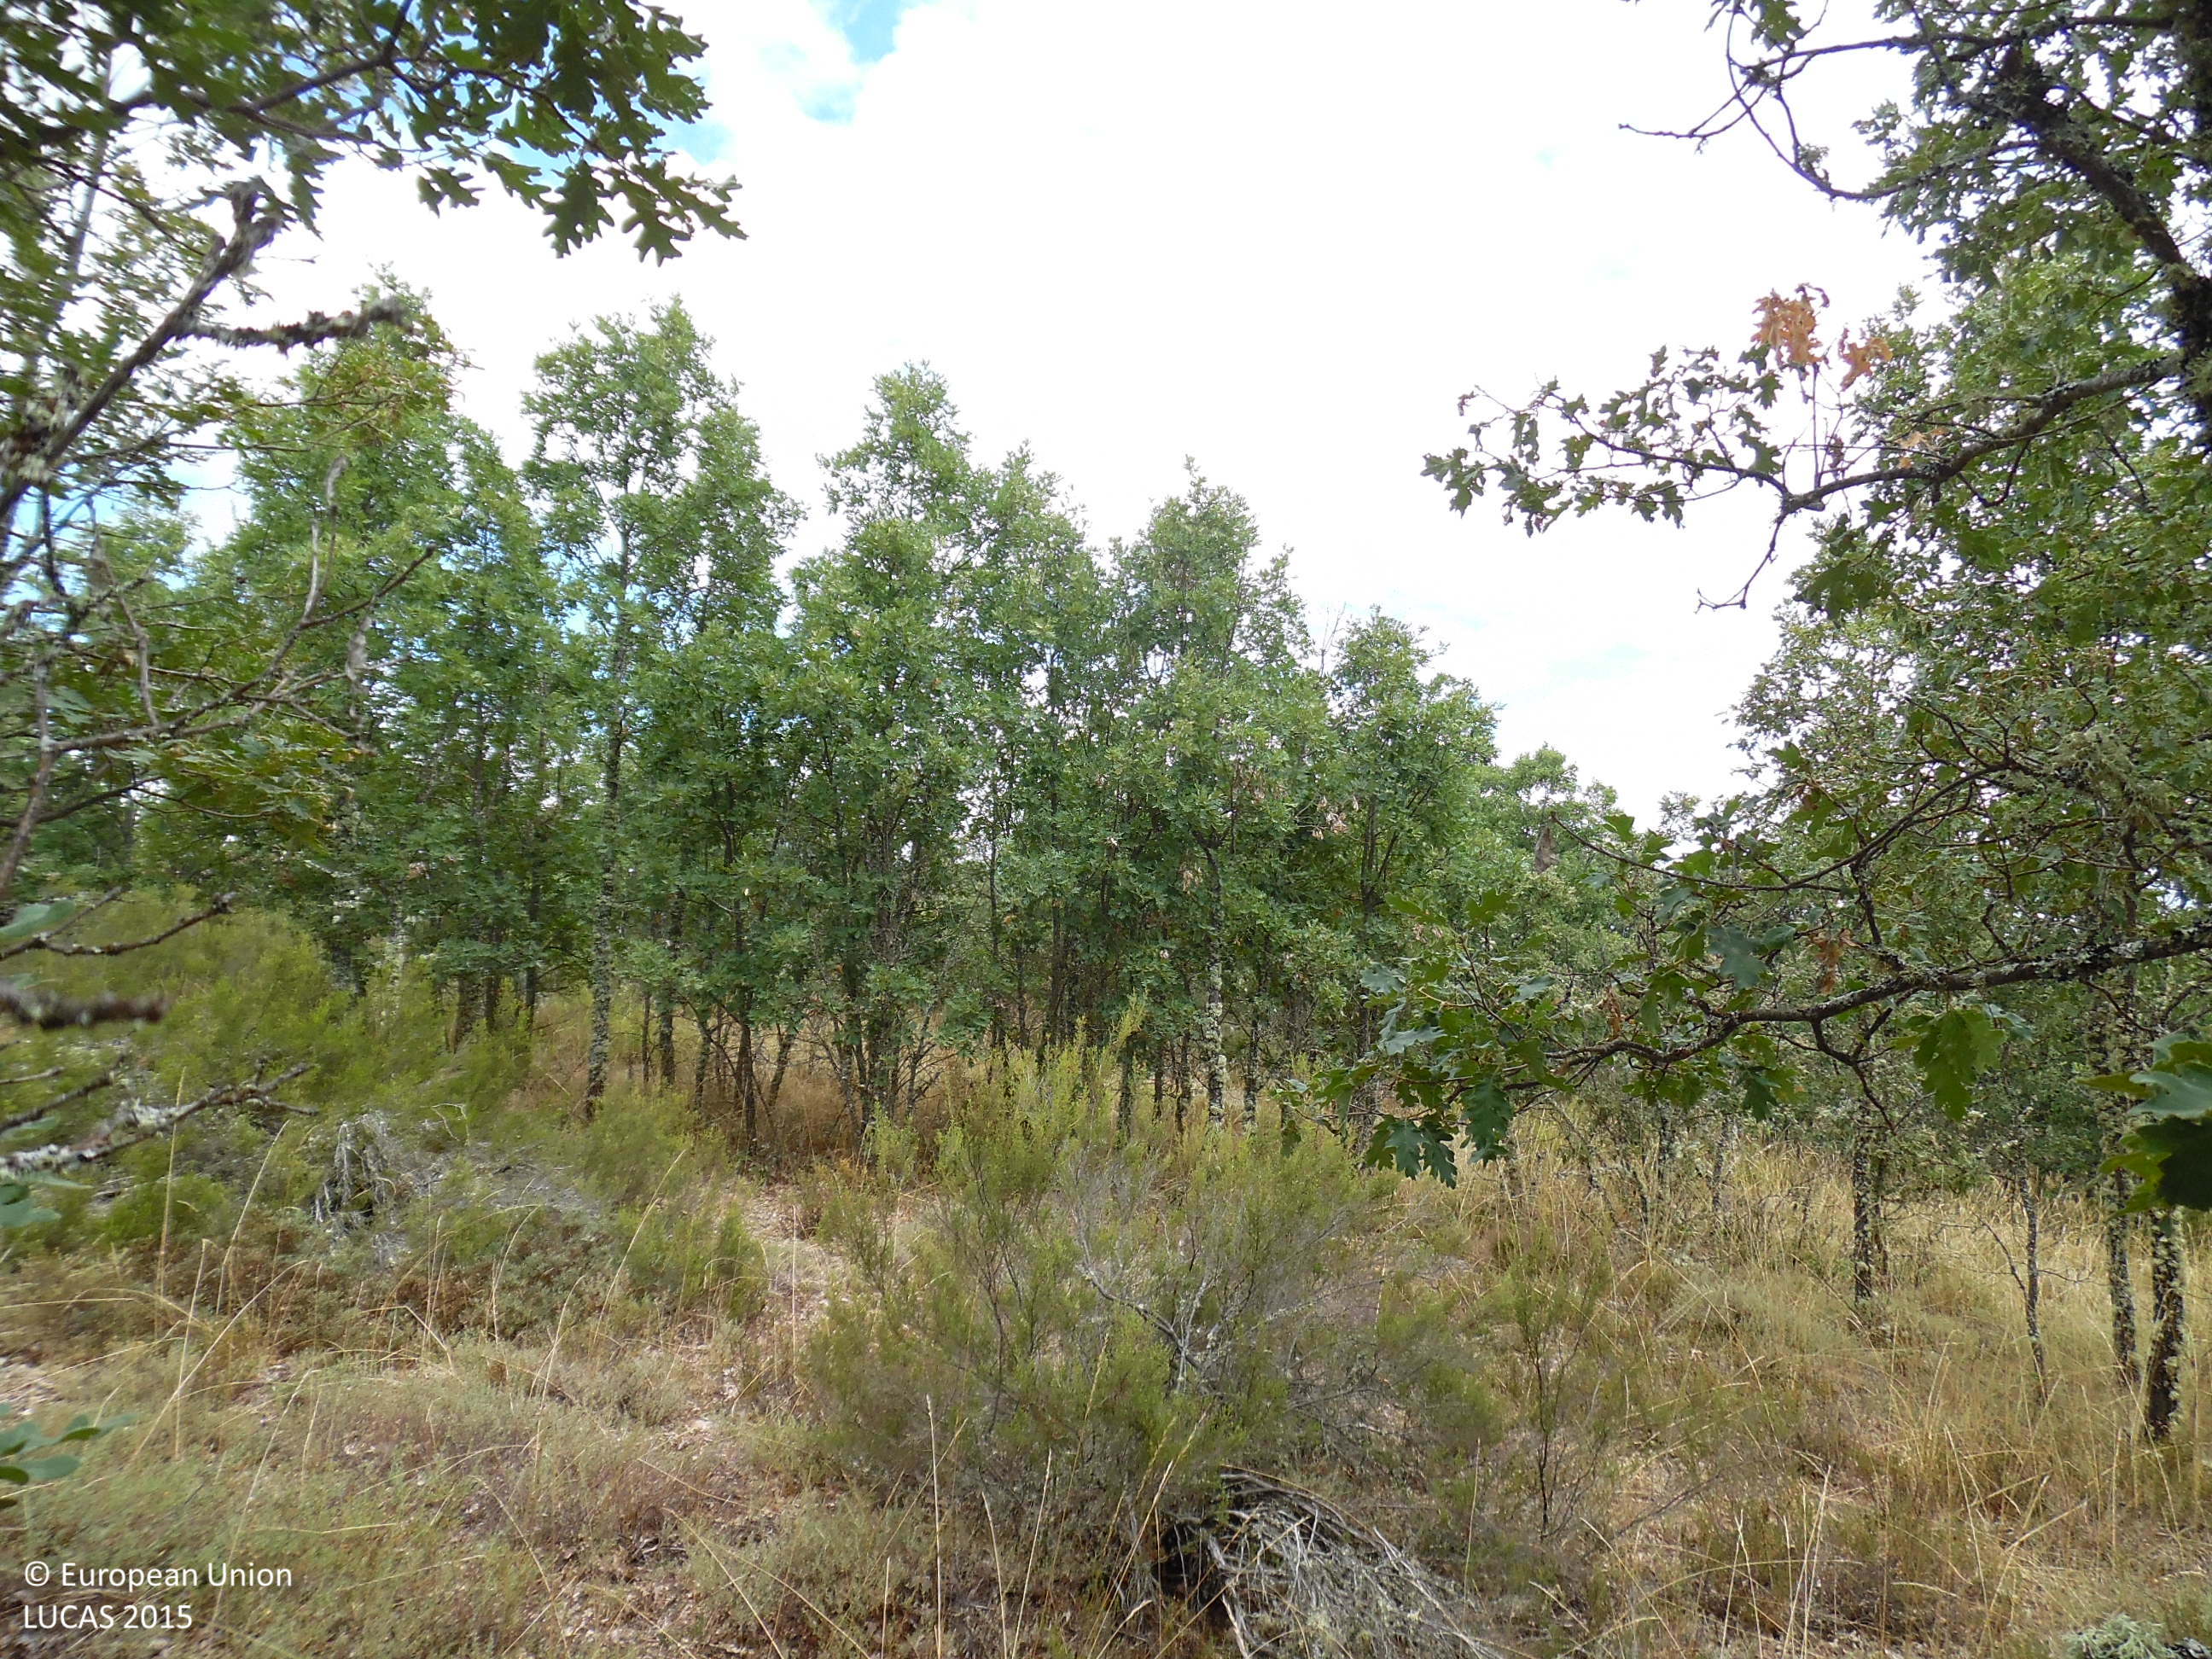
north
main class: Woodland
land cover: Broadleaved woodland
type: thermophilous deciduous forest
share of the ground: > 75 %
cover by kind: broadleaved forest trees 90 %, shrubs 5 %, herbaceous plants 5 %
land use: Forestry
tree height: > 5 m
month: July
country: ES
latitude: 42.6608
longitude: -5.7542
